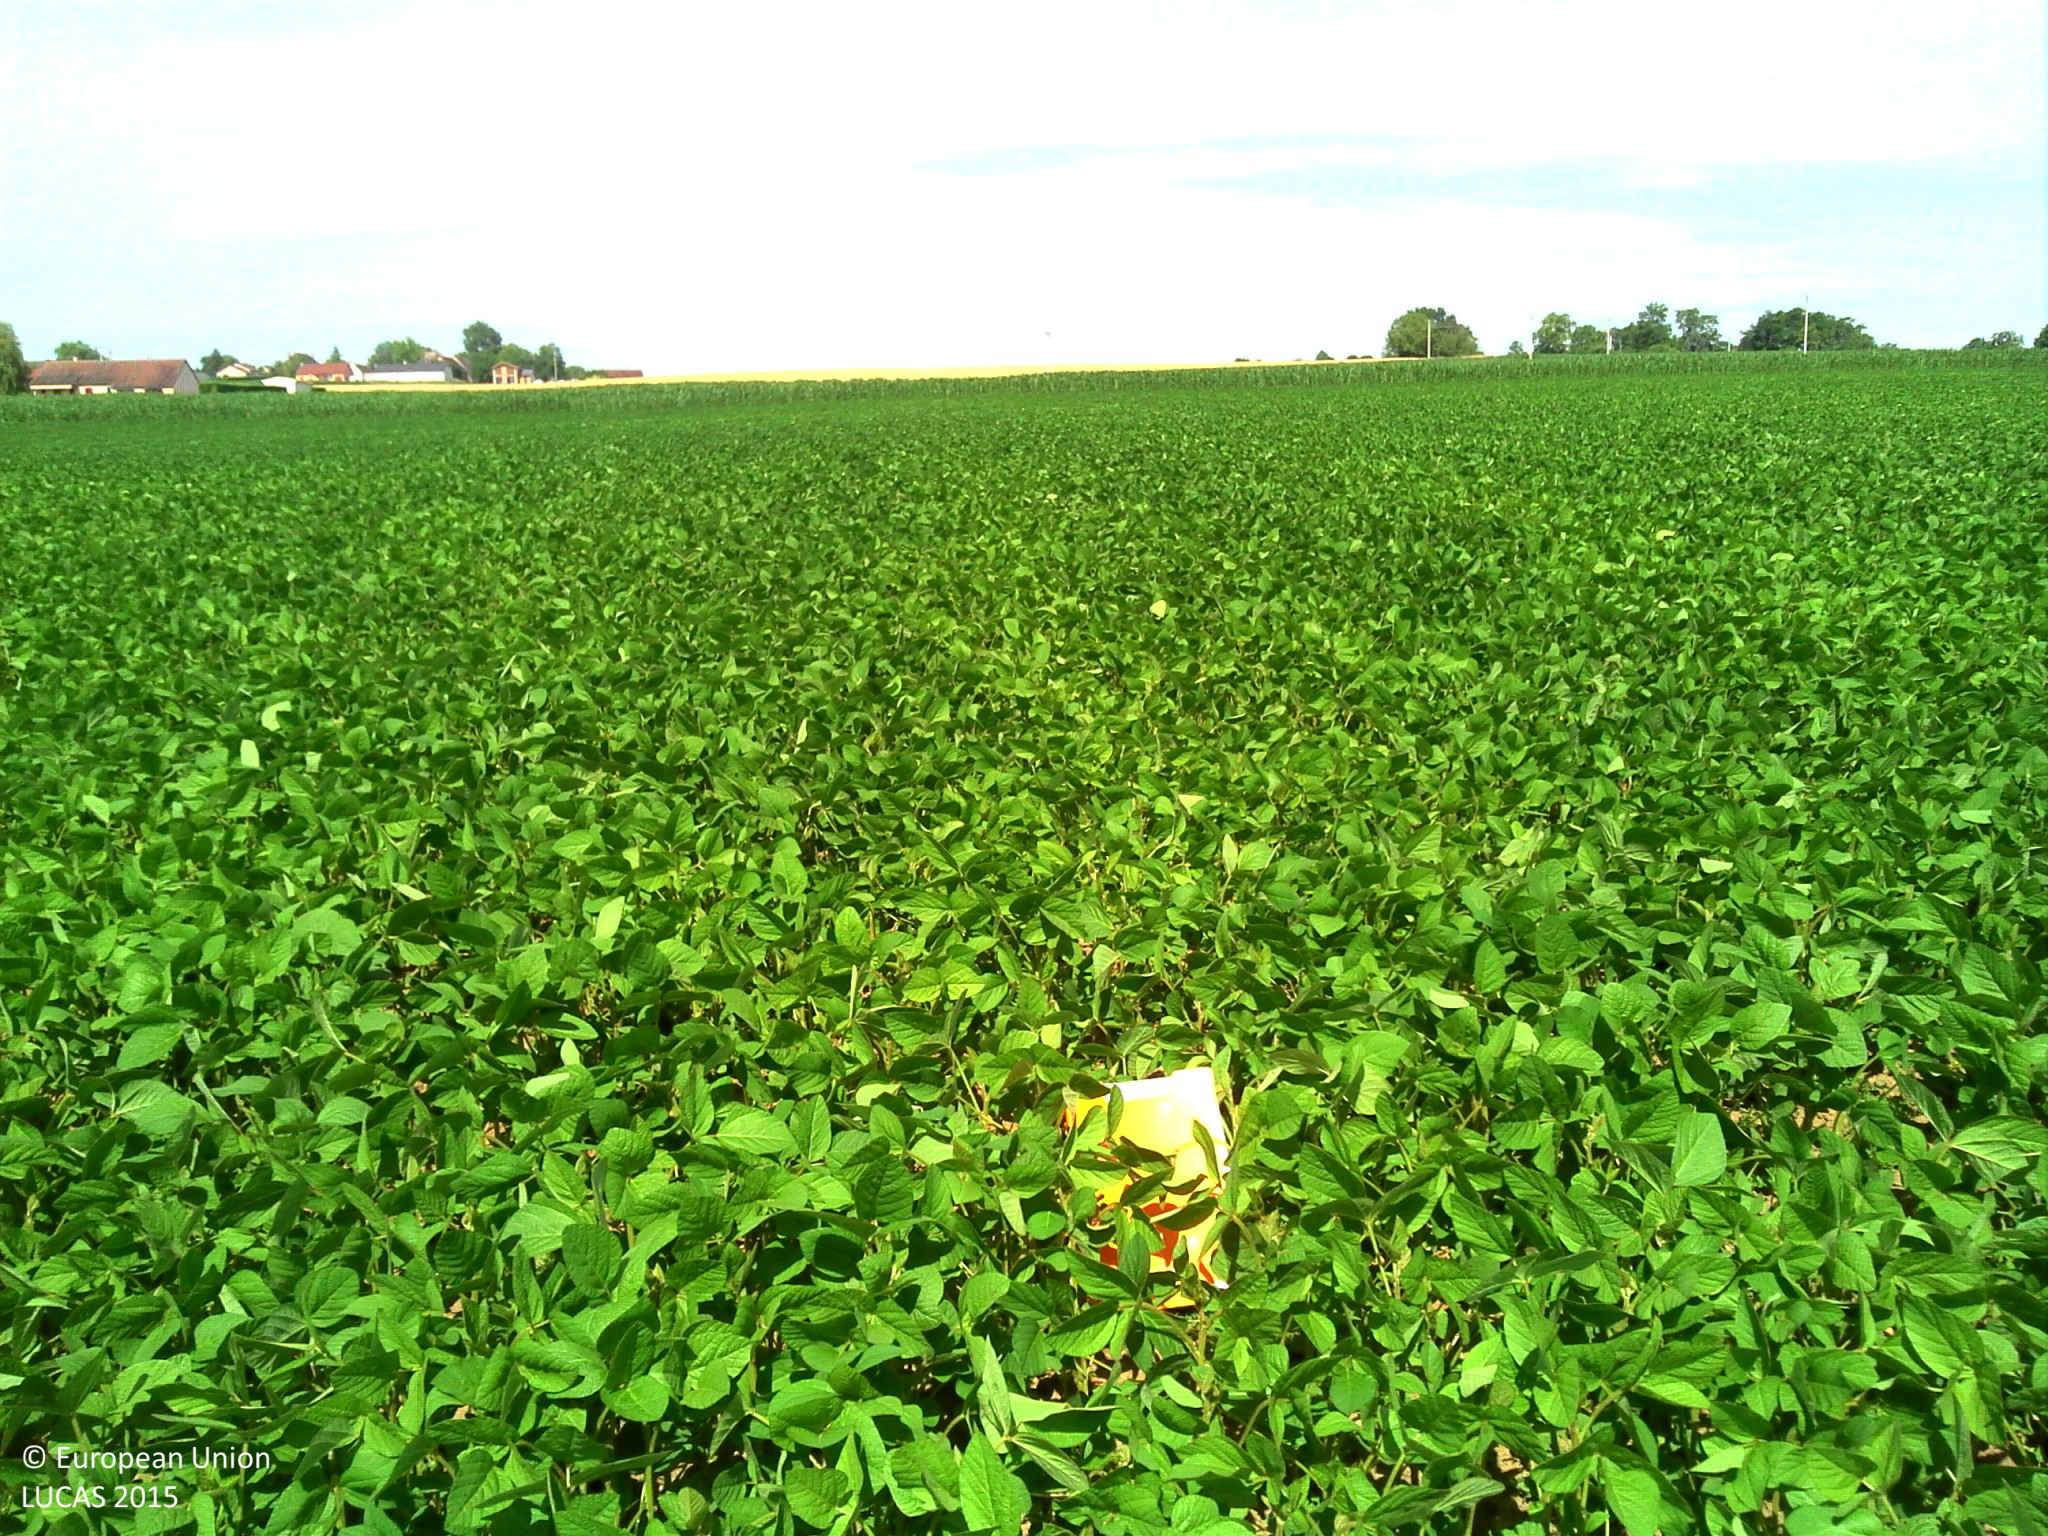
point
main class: Cropland
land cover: Soya
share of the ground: > 75 %
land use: Agriculture (excluding fallow land and kitchen gardens)
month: June
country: FR
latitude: 46.3387
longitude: 3.2818
